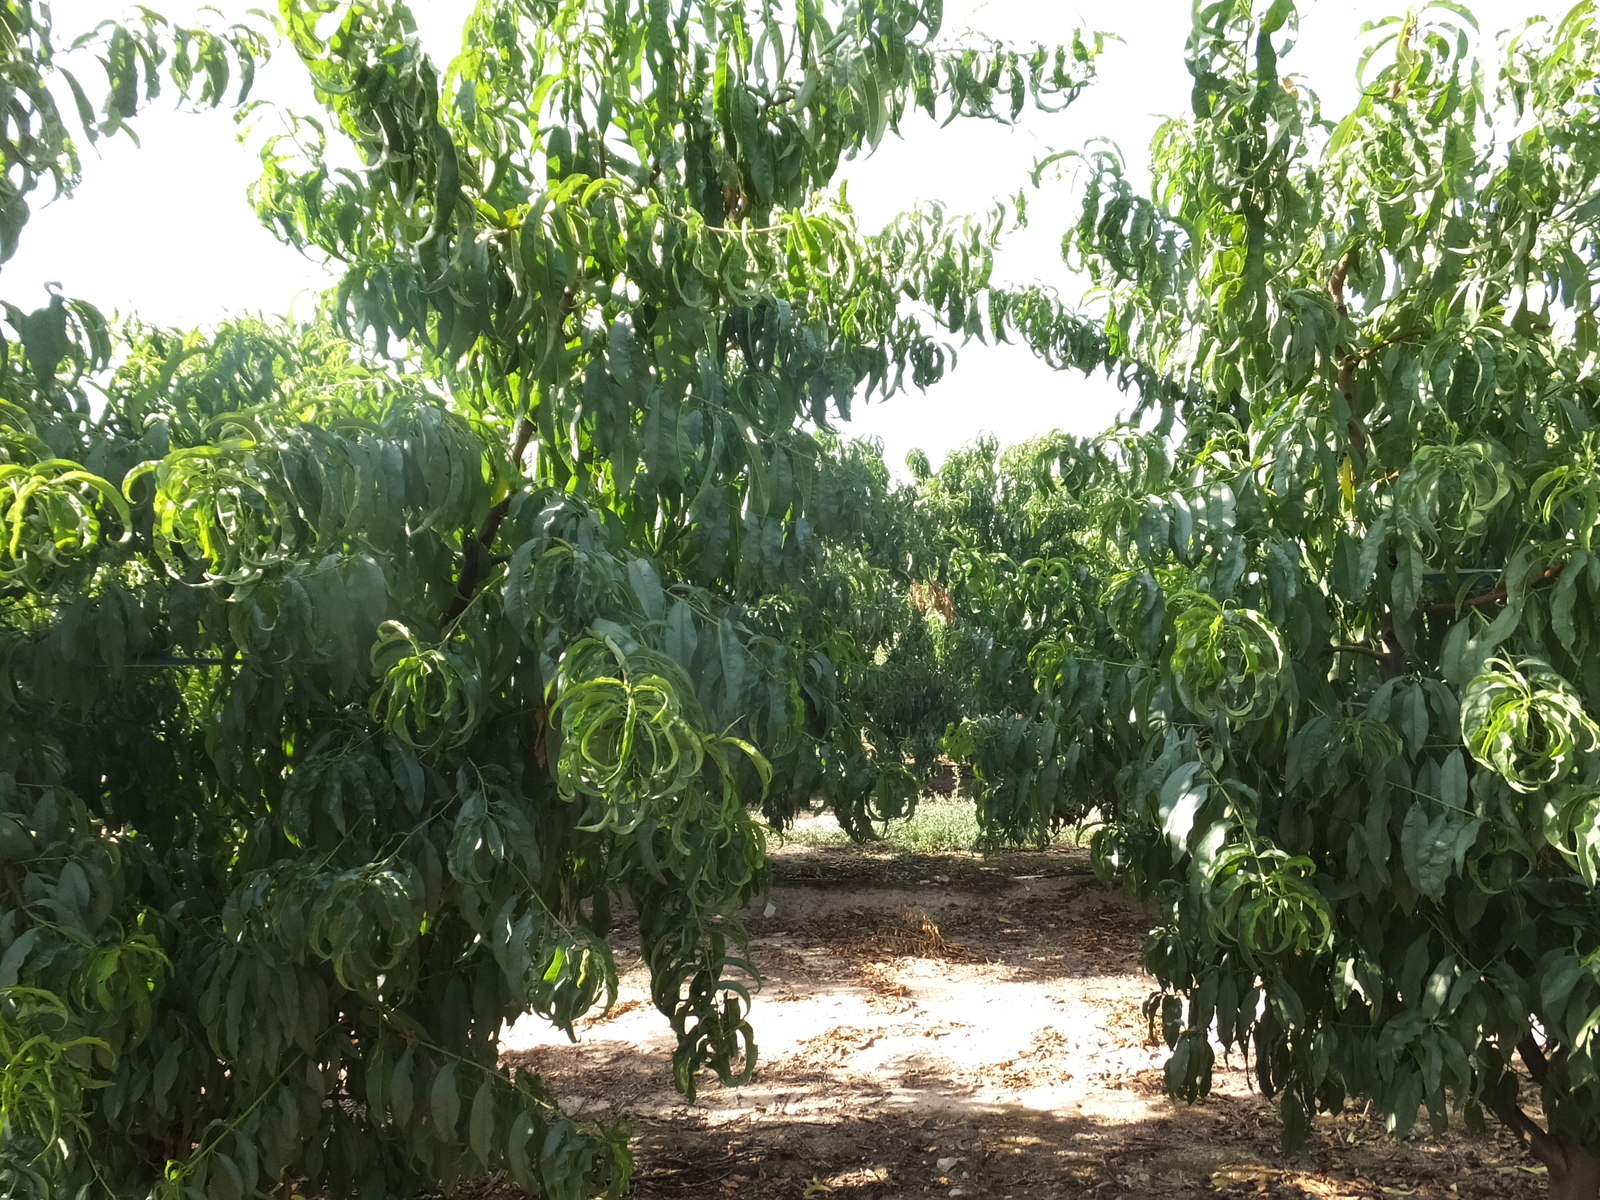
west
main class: Cropland
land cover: Other fruit trees and berries
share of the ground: 50 - 75 %
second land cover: Spontaneously vegetated surfaces
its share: 10 - 25 %
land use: Agriculture (excluding fallow land and kitchen gardens)
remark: Harvested field
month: August
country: ES
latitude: 41.6105
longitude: 0.3505
